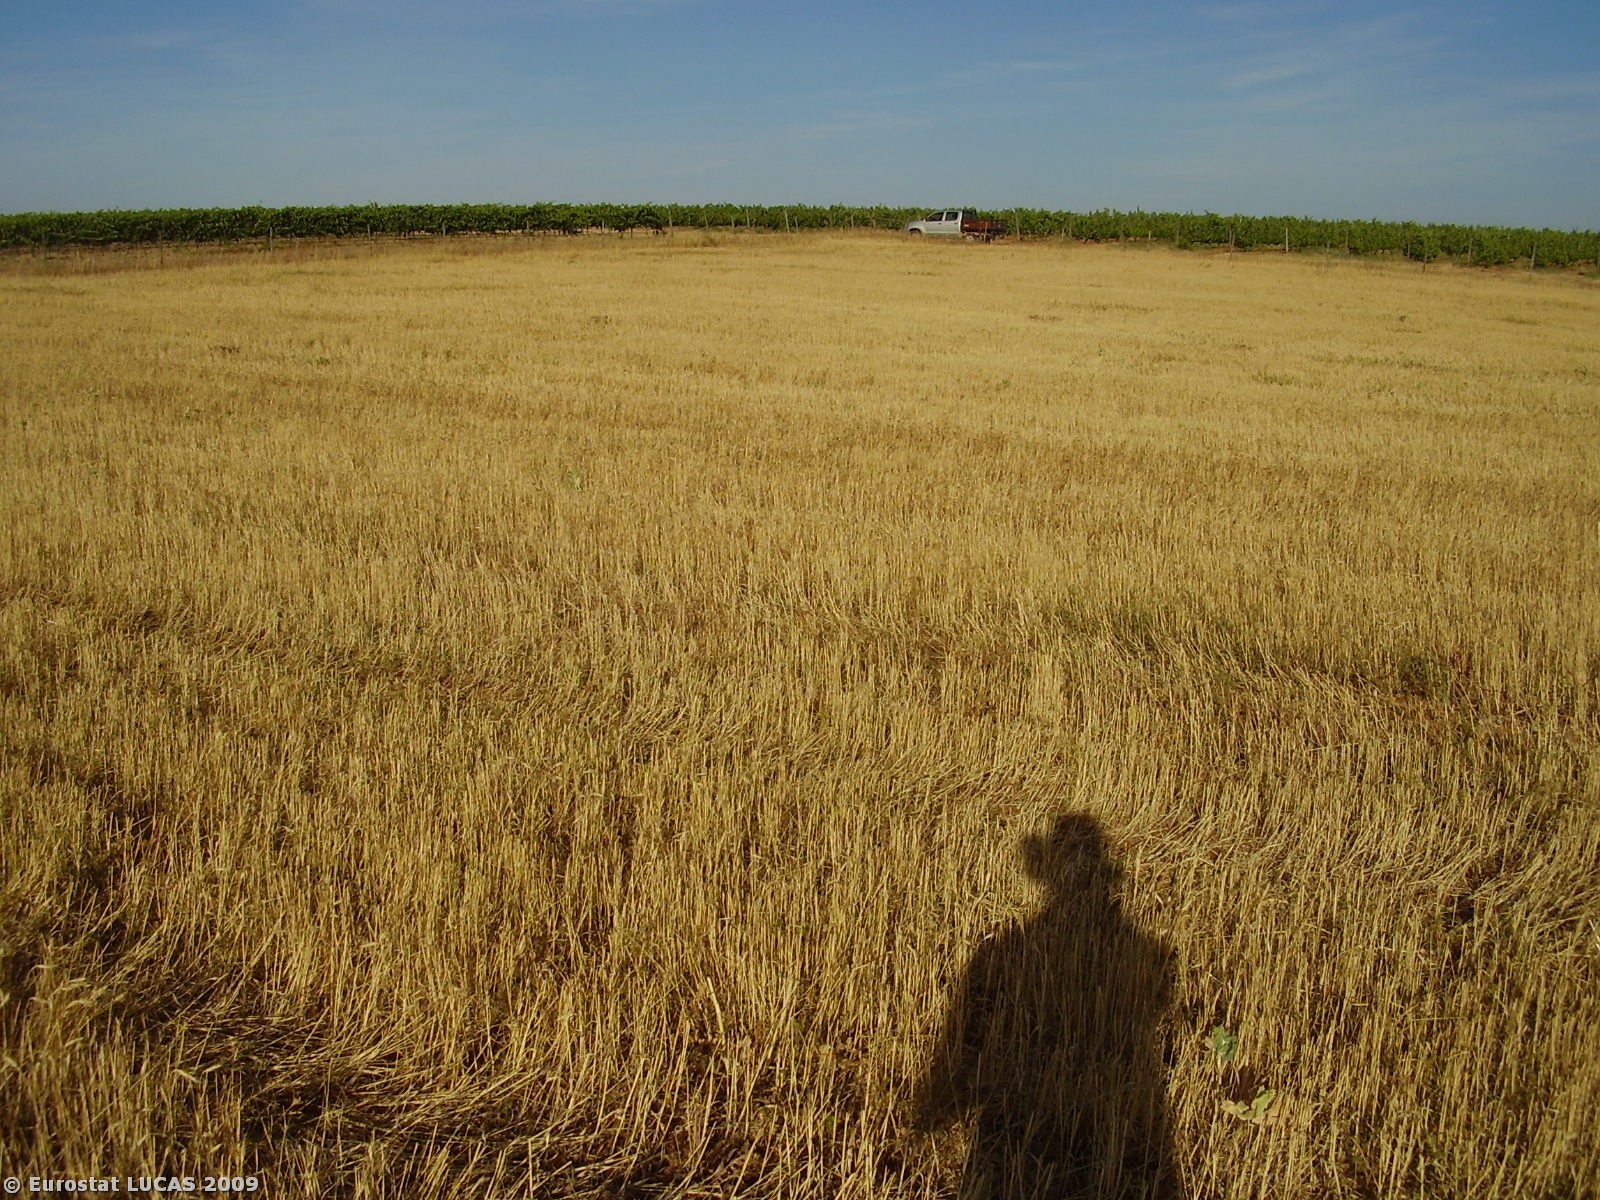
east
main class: Cropland
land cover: Triticale
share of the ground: > 75 %
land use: Agriculture (excluding fallow land and kitchen gardens)
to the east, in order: Triticale; Fences; Spontaneously vegetated surfaces; Vineyards; Spontaneously vegetated surfaces; Vineyards
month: July
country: PT
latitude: 38.4685
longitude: -7.6475
